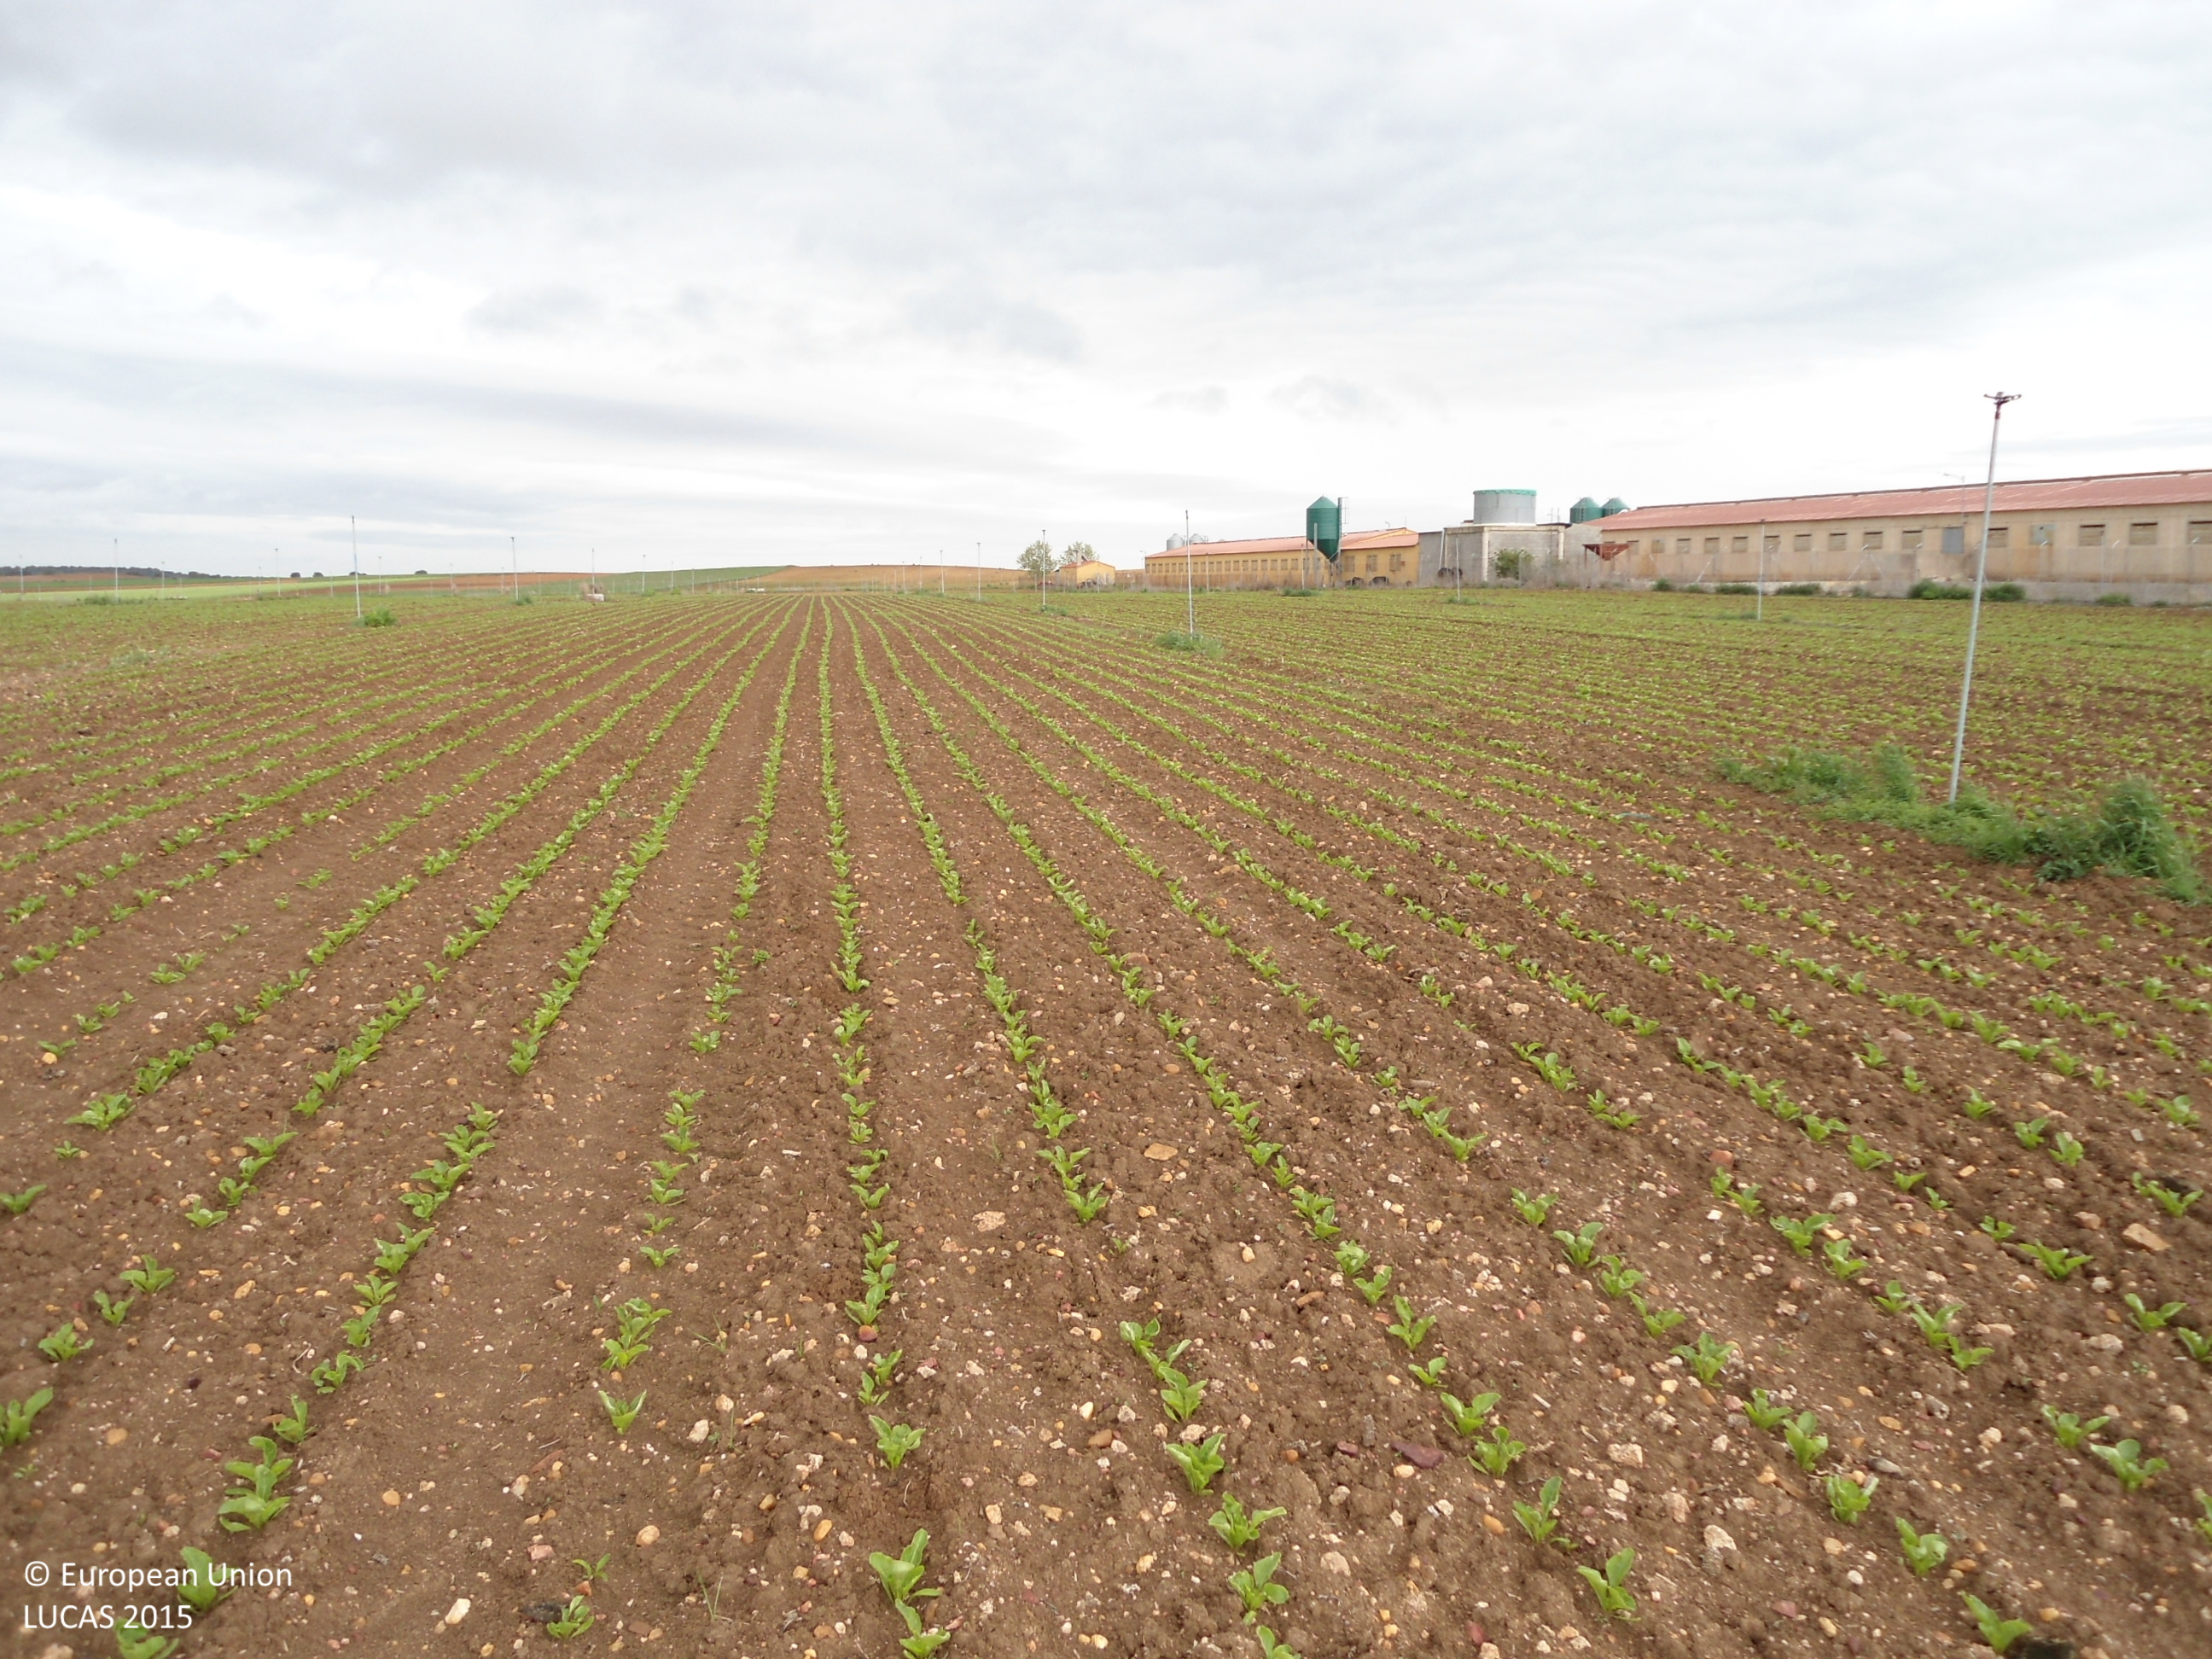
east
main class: Cropland
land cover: Sugar beet
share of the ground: 25 - 50 %
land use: Agriculture (excluding fallow land and kitchen gardens)
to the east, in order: Sugar beet; Grass margins; Paved roads, cycling and walking lanes; Grass margins; Sugar beet
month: May
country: ES
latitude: 41.7800
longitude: -5.8660
